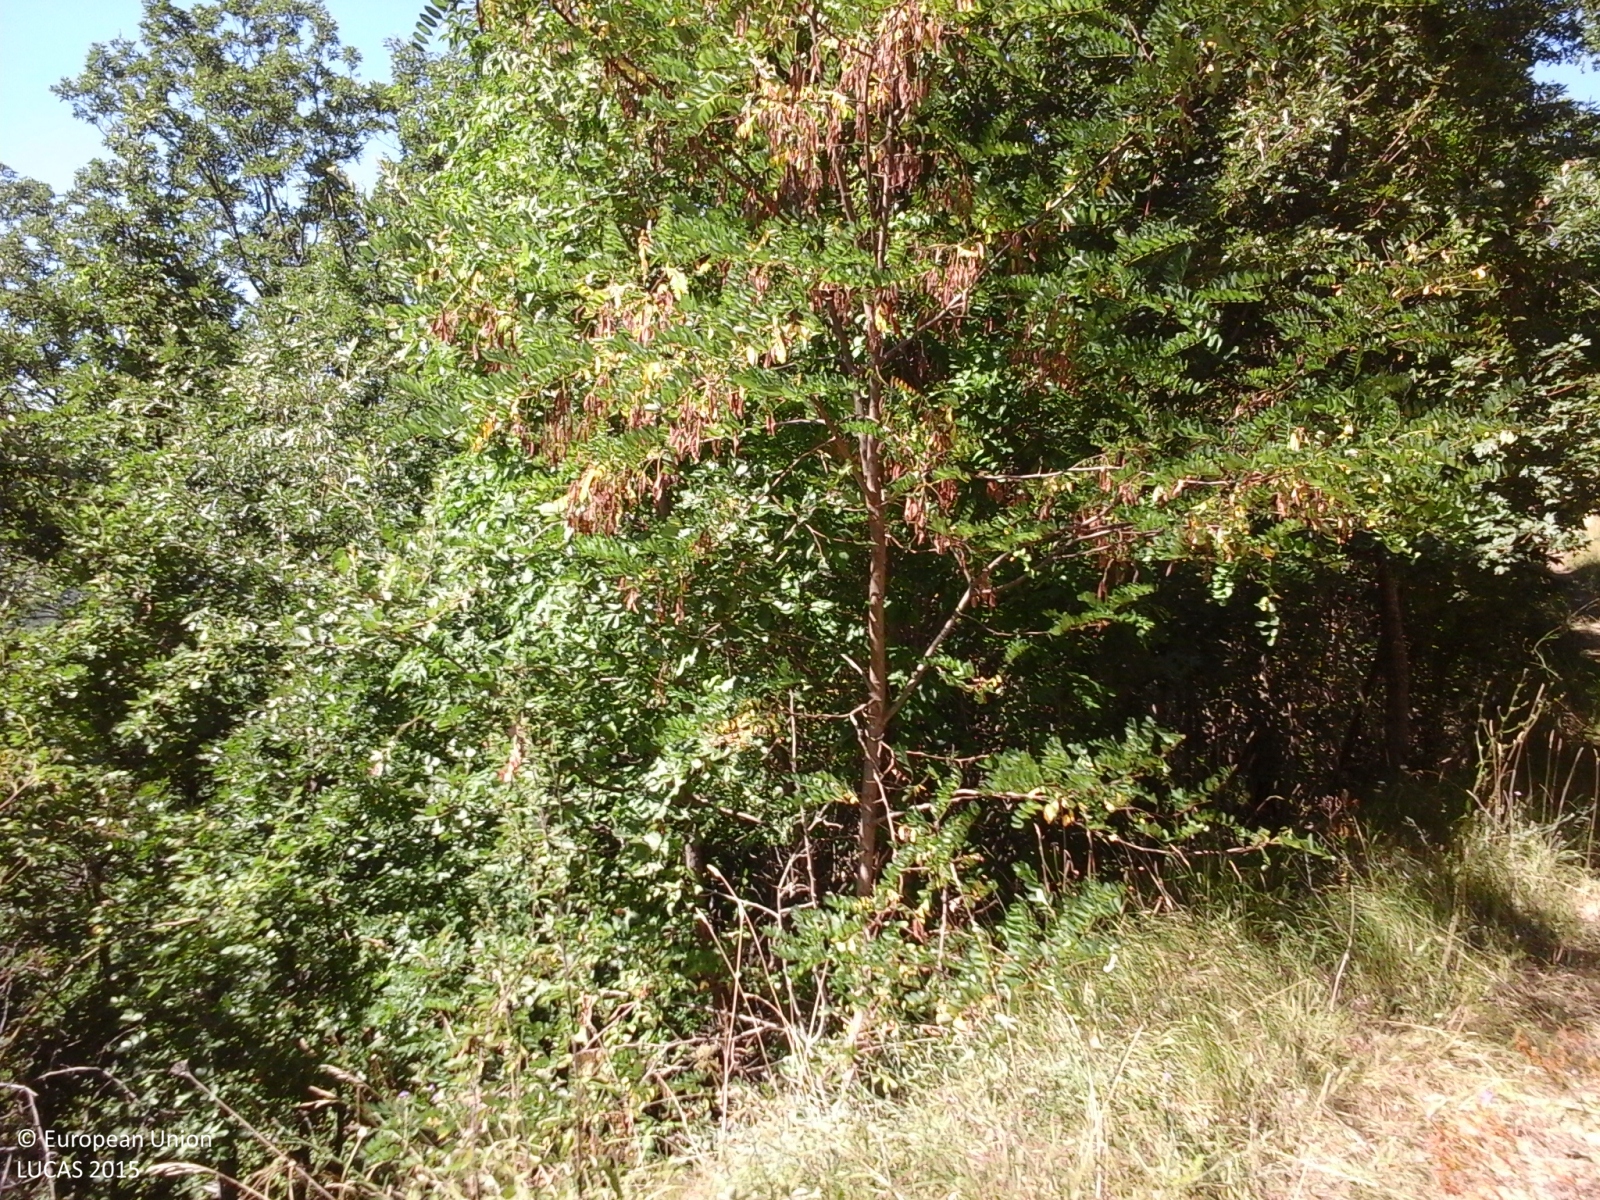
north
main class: Woodland
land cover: Broadleaved woodland
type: thermophilous deciduous forest
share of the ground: > 75 %
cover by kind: broadleaved forest trees 100 %
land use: Forestry
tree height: > 5 m
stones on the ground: < 10 %
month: August
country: IT
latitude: 43.5471
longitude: 12.3826
